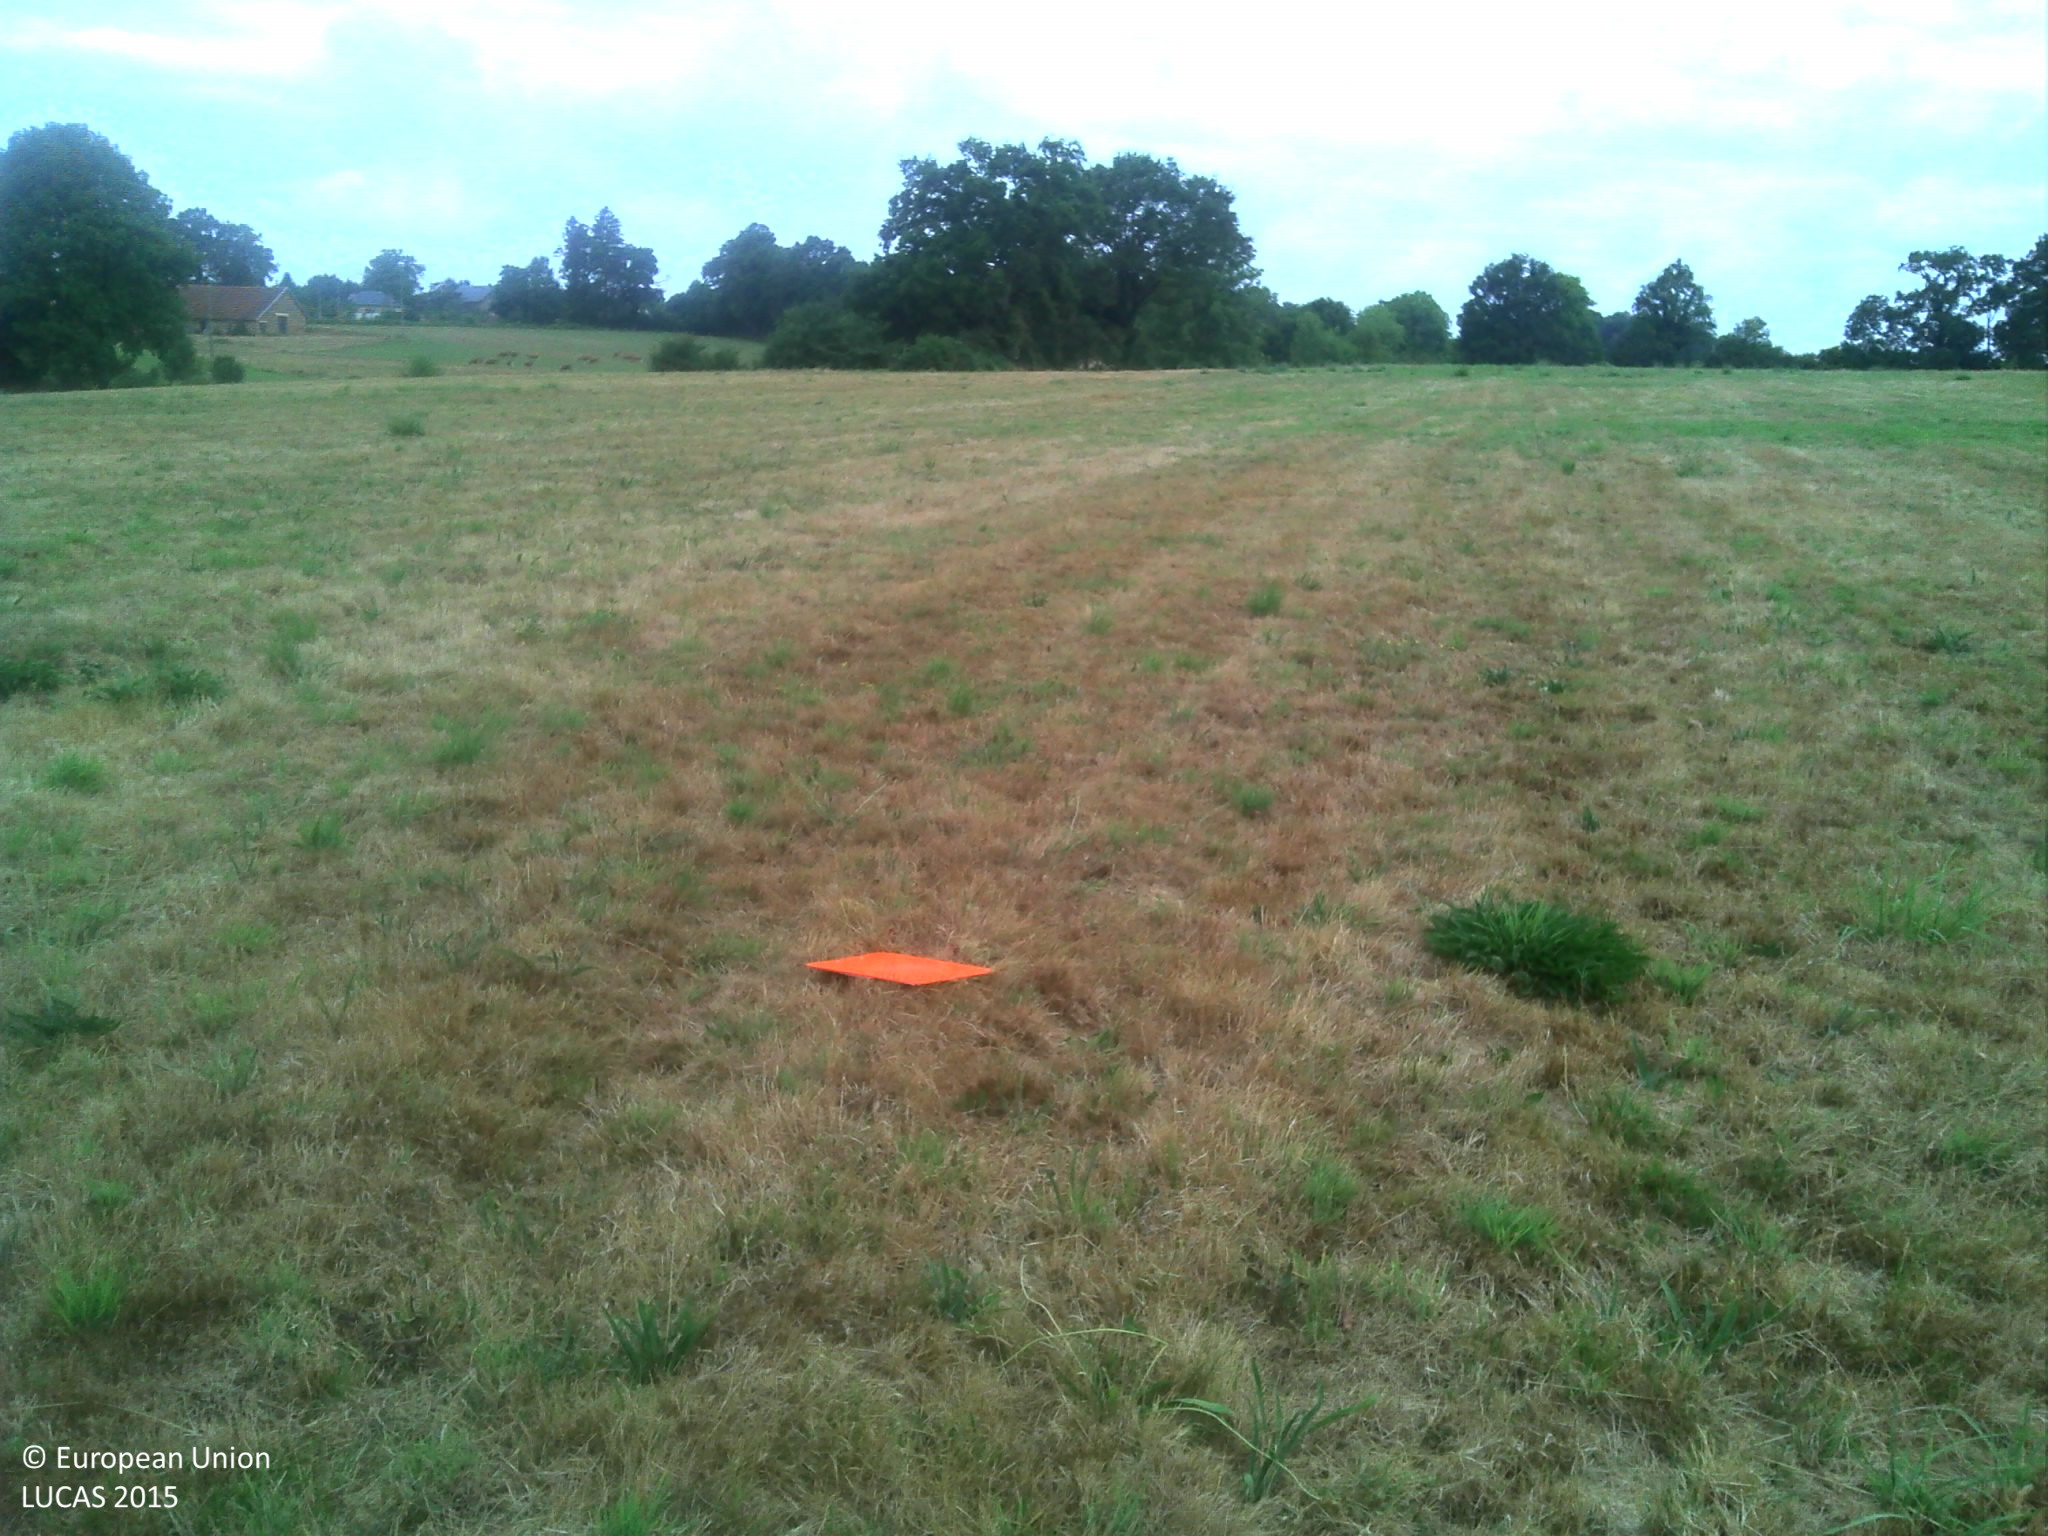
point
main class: Grassland
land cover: Grassland without tree/shrub cover
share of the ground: > 75 %
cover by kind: herbaceous plants 95 %, shrubs 5 %
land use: Agriculture (excluding fallow land and kitchen gardens)
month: July
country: FR
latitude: 45.3966
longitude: 1.4992
